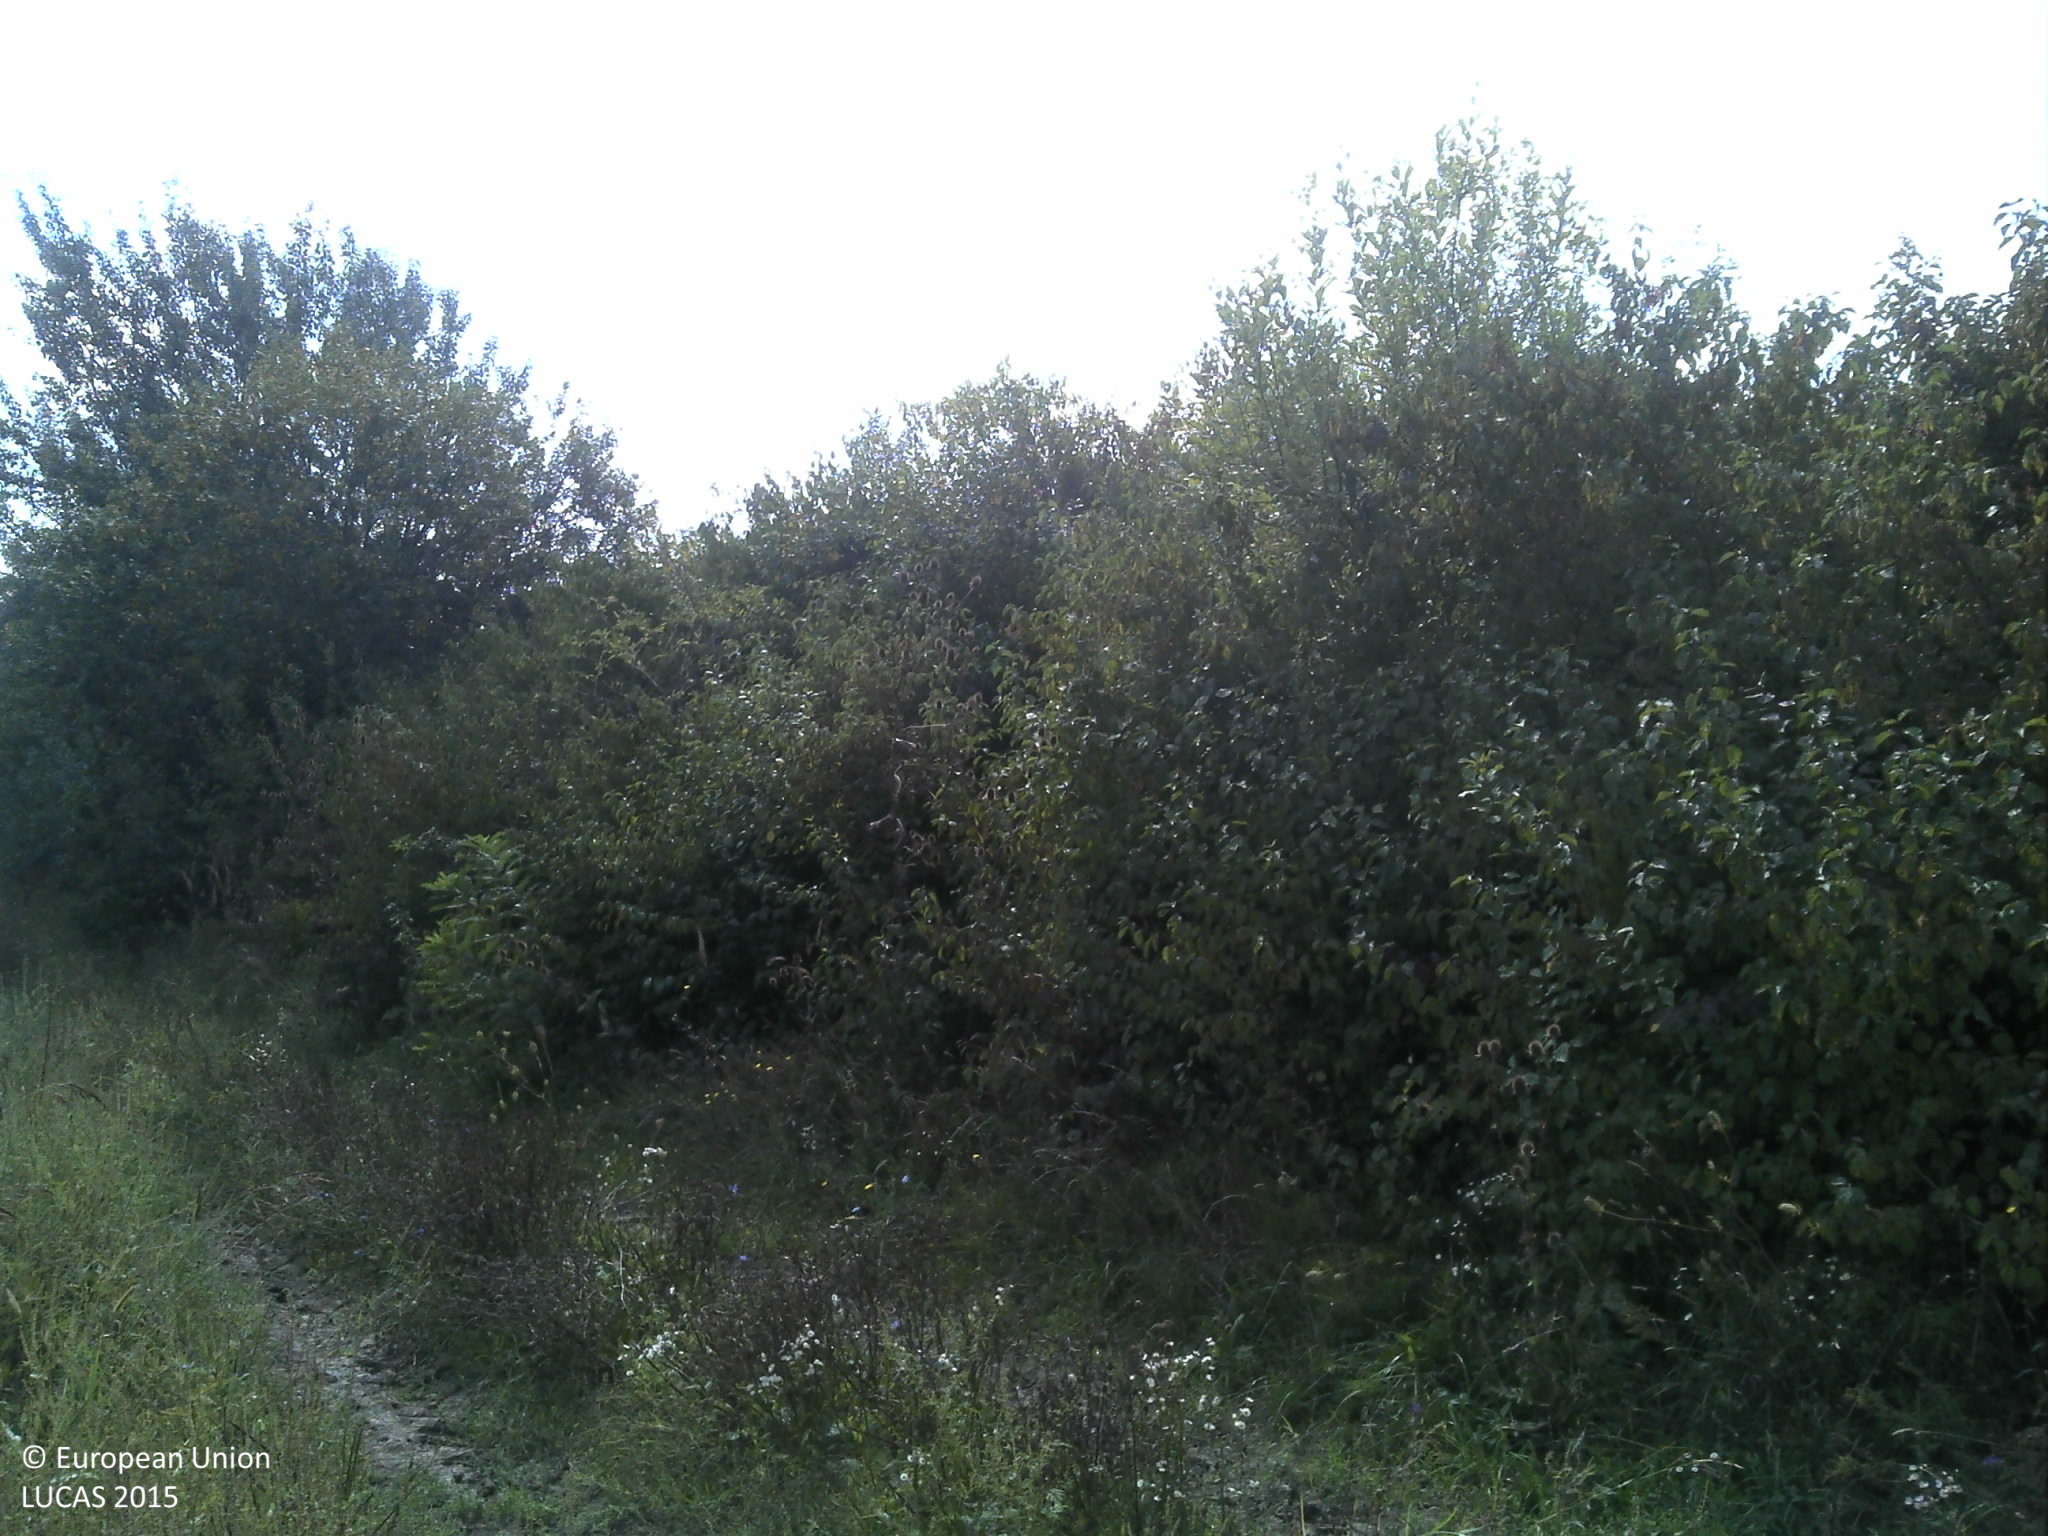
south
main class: Grassland
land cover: Spontaneously vegetated surfaces
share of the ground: > 75 %
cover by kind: herbaceous plants 100 %
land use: Agriculture (excluding fallow land and kitchen gardens)
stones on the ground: < 10 %
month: September
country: HR
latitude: 45.1219
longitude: 18.9701
